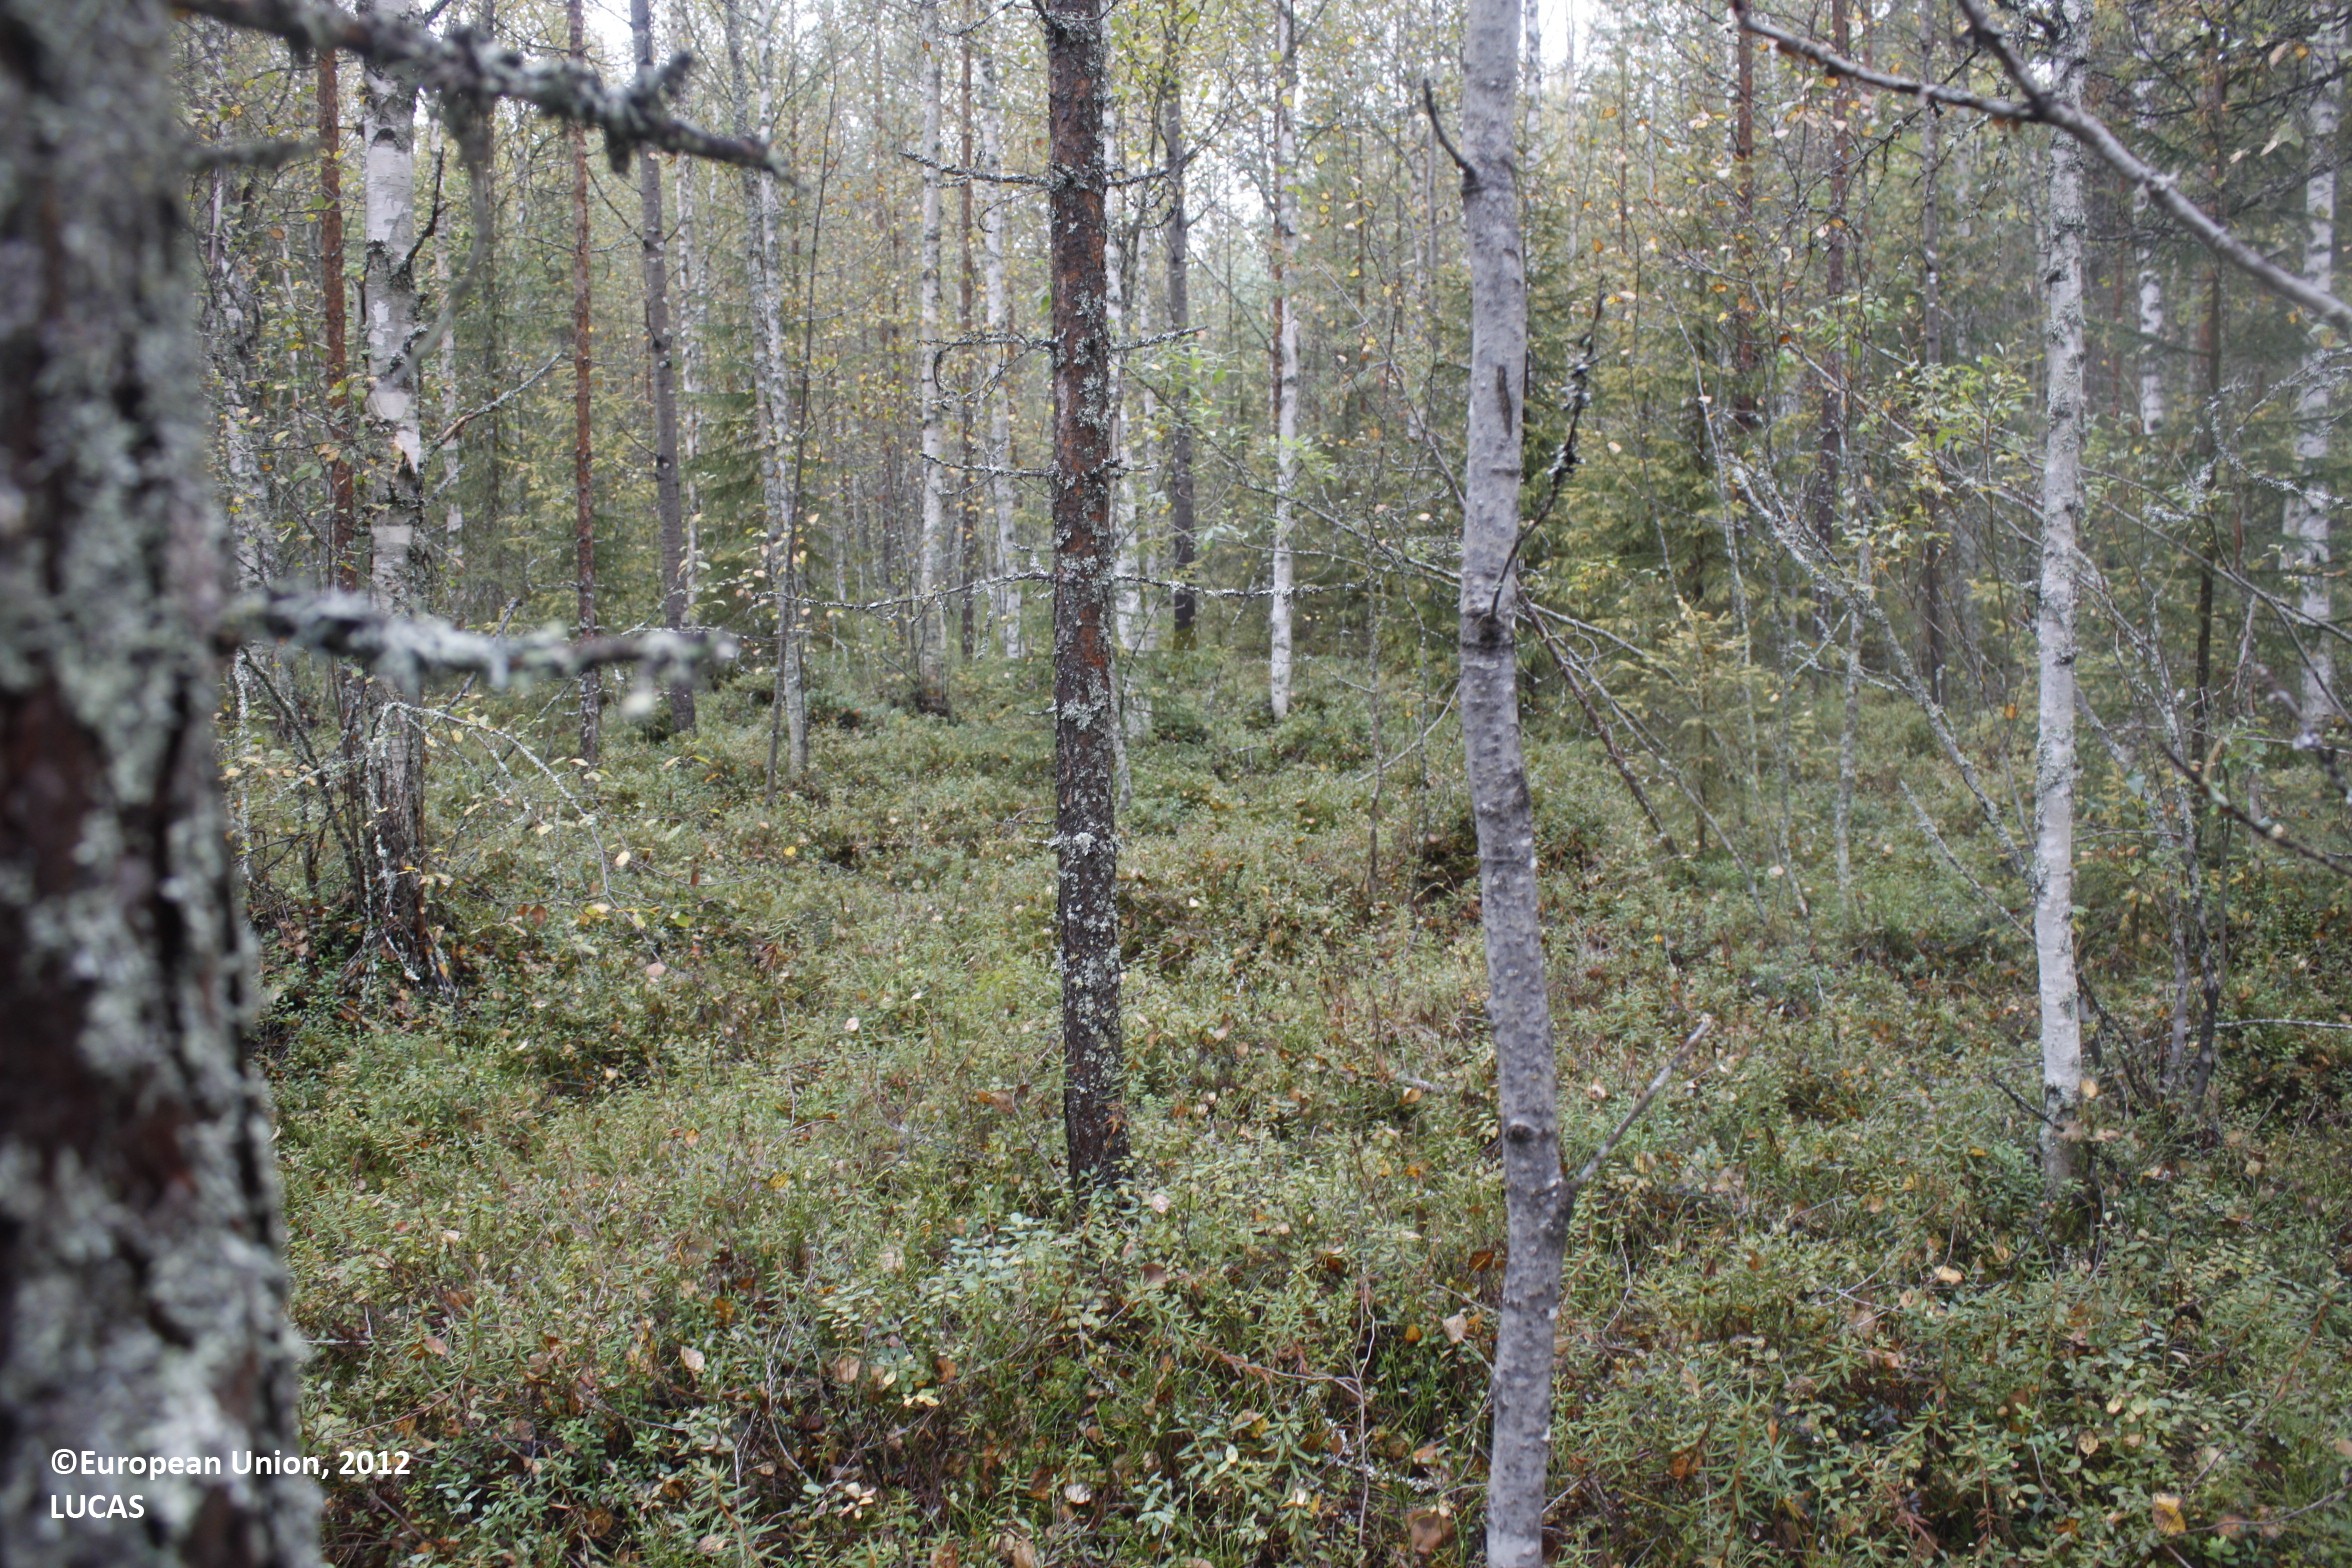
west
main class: Woodland
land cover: Other mixed woodland
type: boreal forest
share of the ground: 50 - 75 %
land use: Forestry
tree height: > 5 m
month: September
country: FI
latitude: 65.1398
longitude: 26.6750
